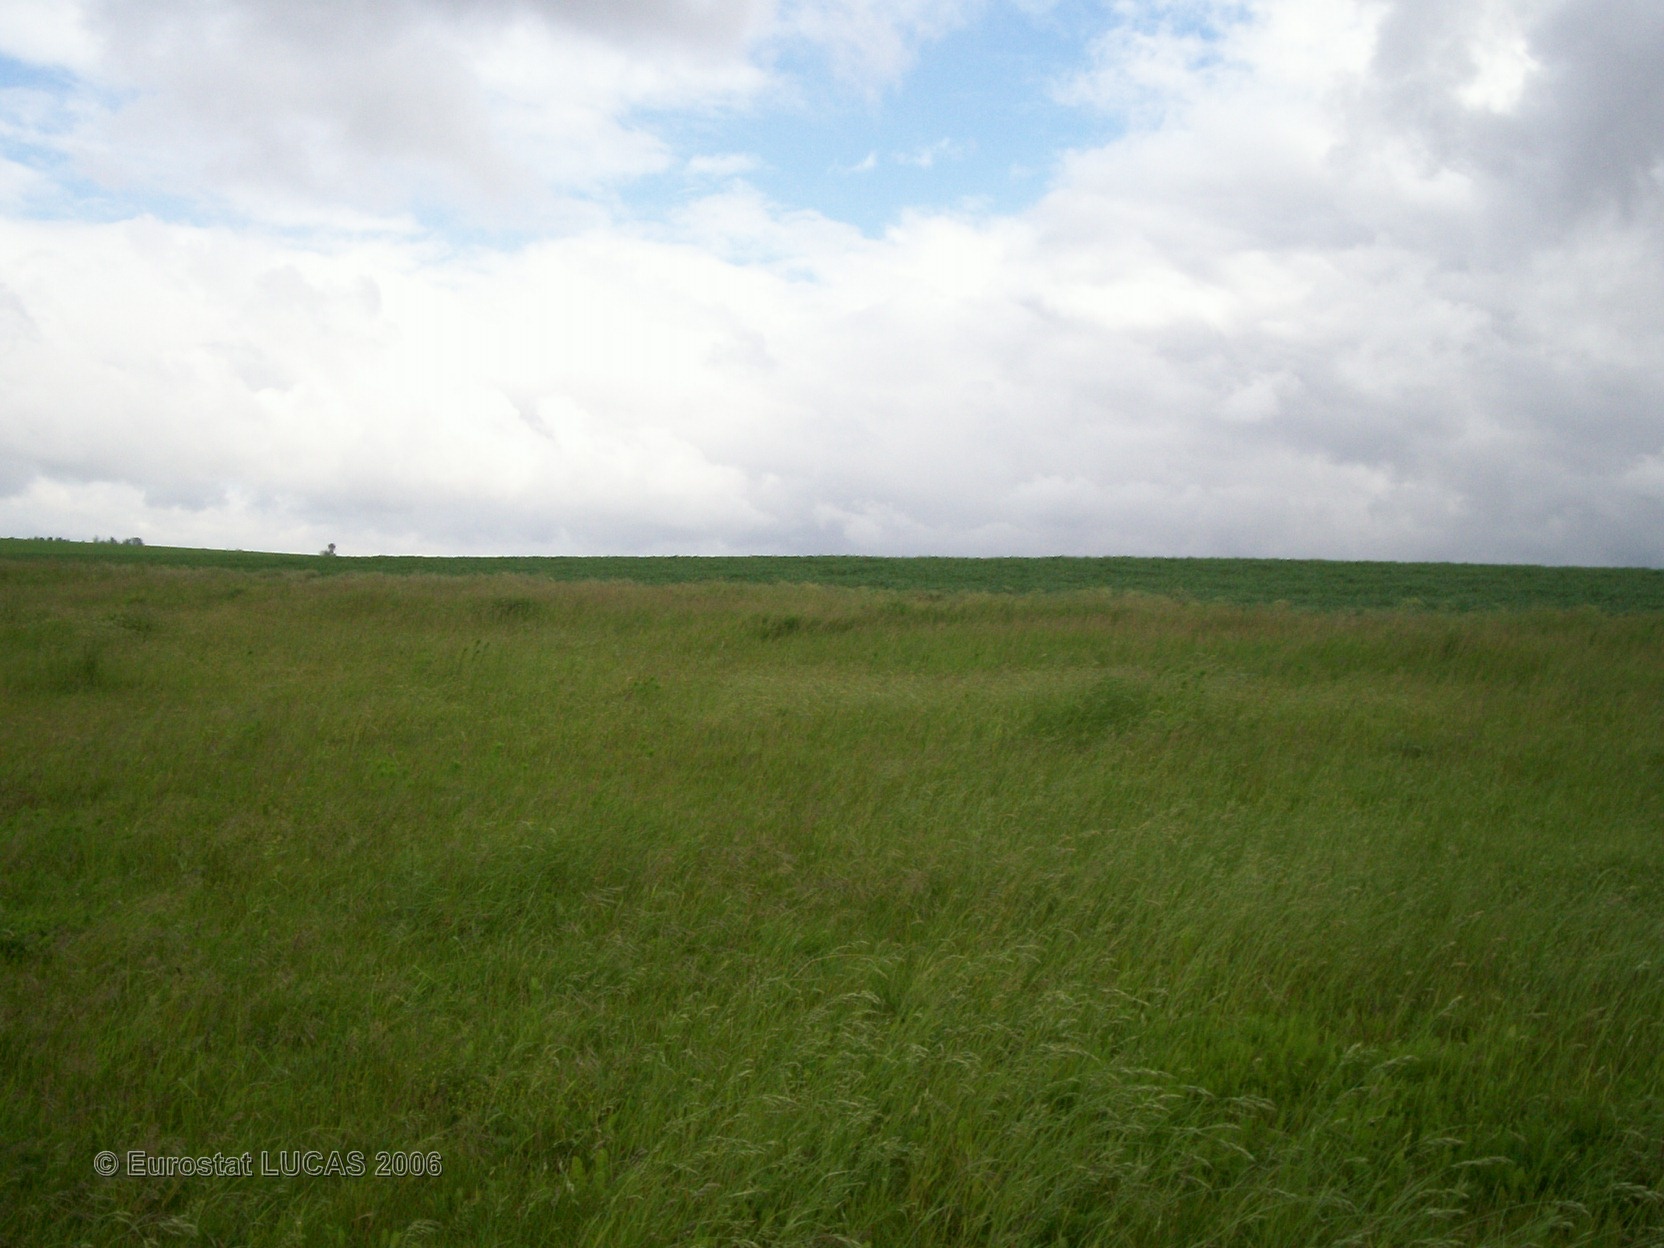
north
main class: Grassland
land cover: Grassland without tree/shrub cover
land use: Agriculture (excluding fallow land and kitchen gardens)
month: May
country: FR
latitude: 49.7726
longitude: 3.6475
